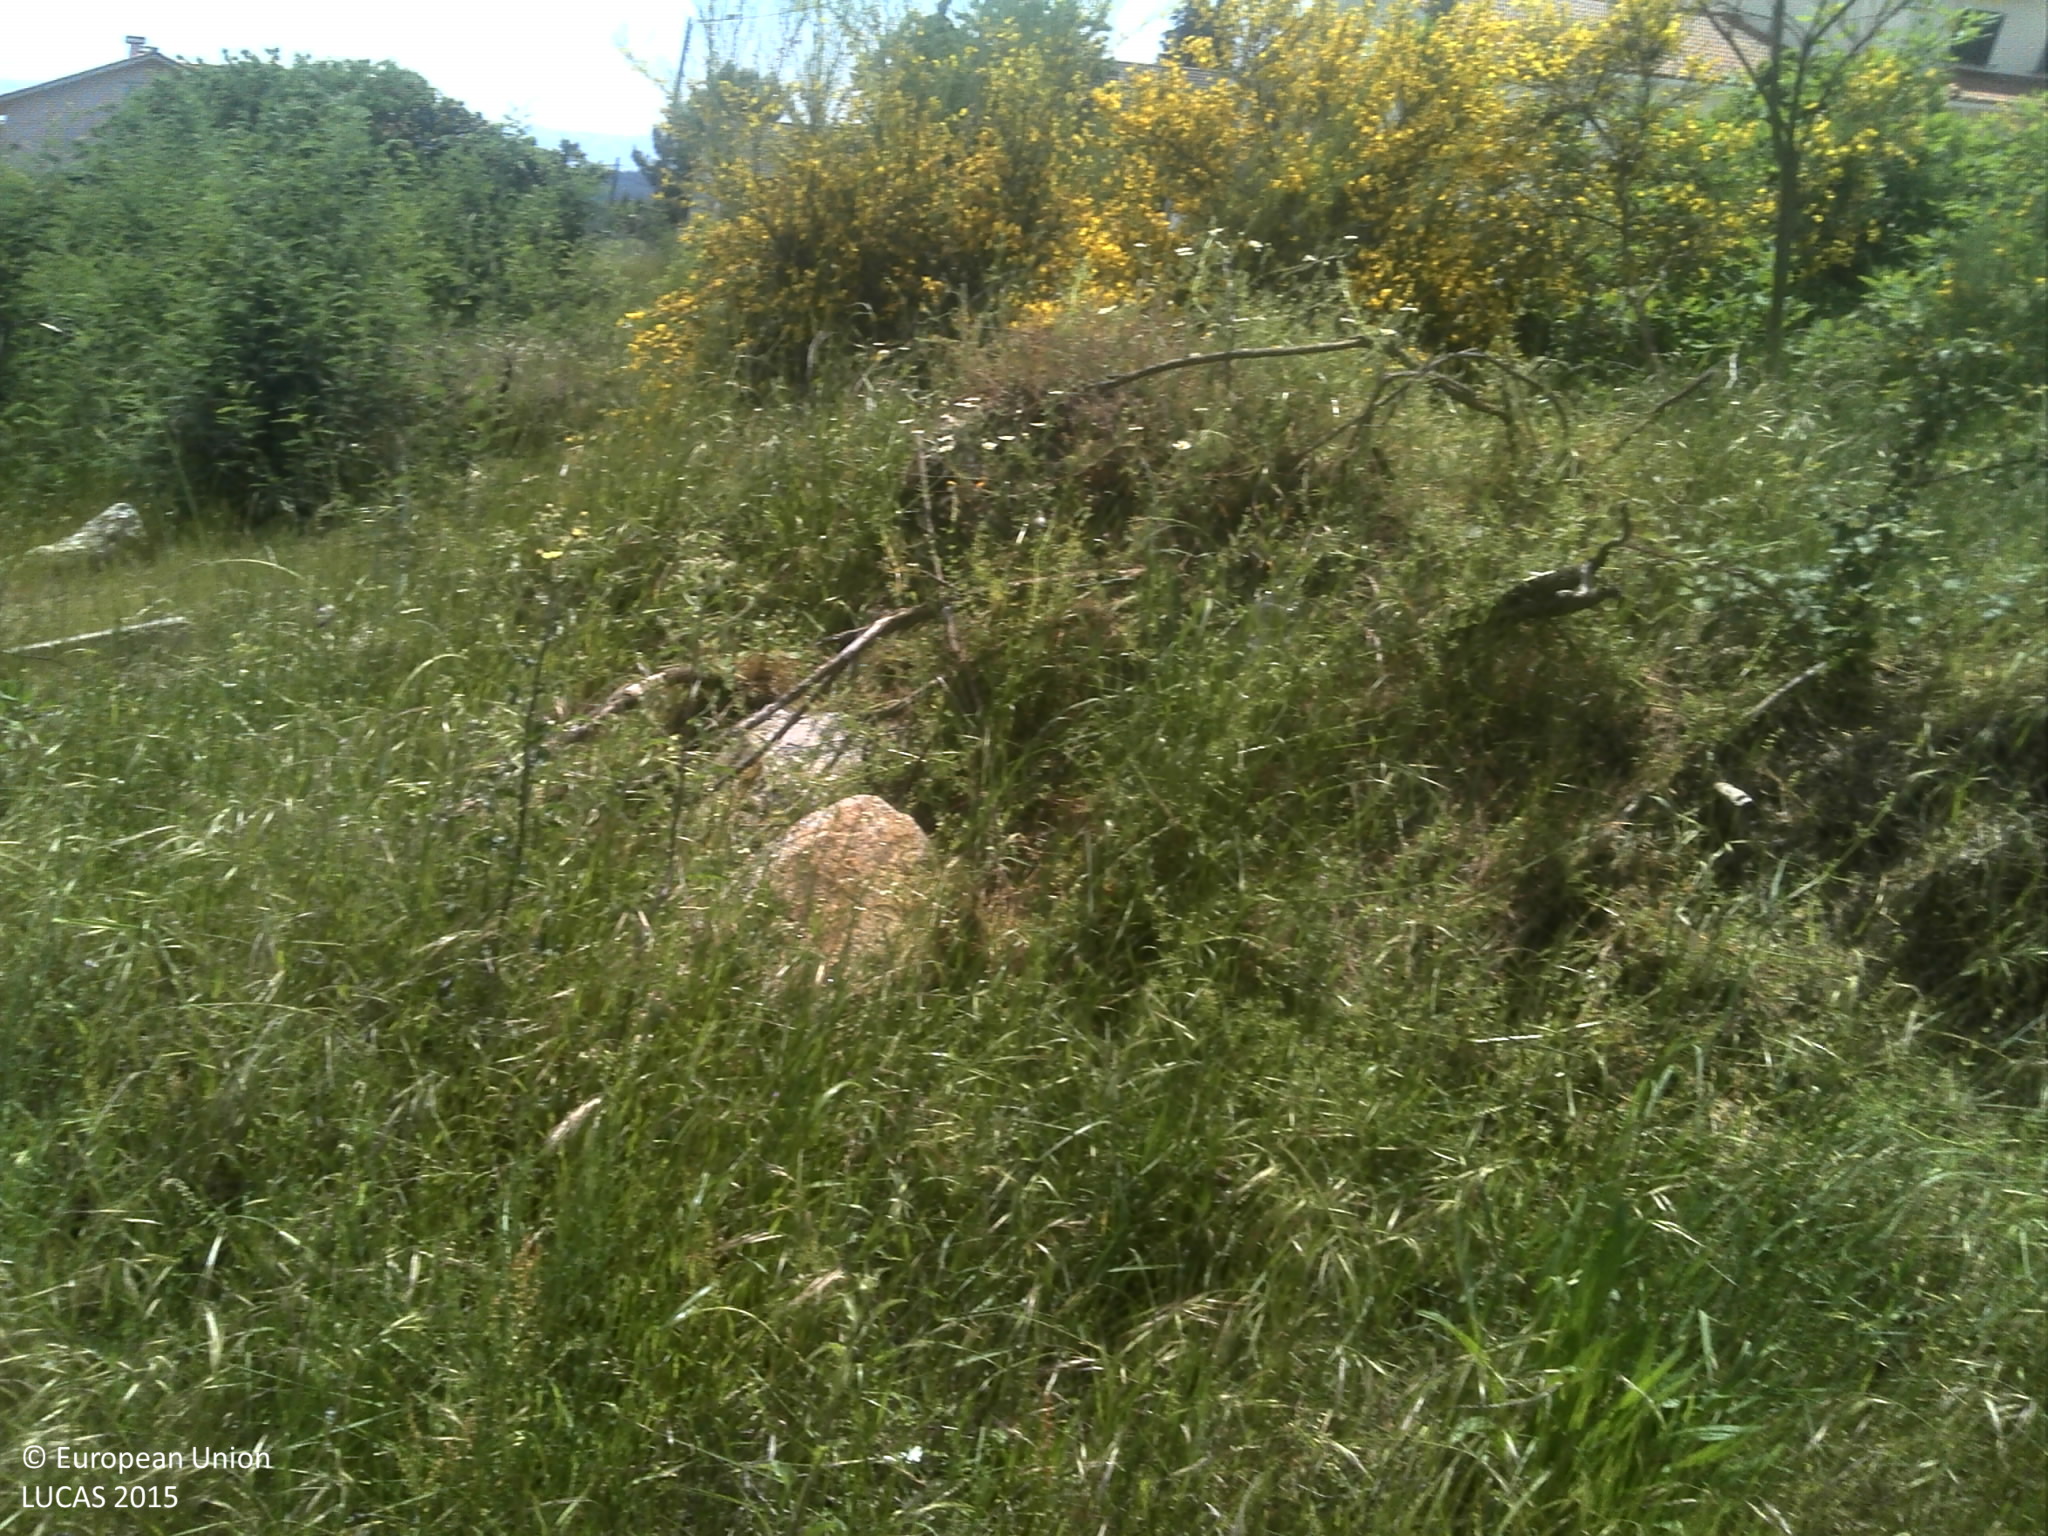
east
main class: Shrubland
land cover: Shrubland without tree cover
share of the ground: 25 - 50 %
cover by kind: shrubs 65 %, herbaceous plants 20 %, consolidated bare surface 15 %
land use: Abandoned areas
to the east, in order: Shrubland without tree cover; Electric lines; Shrubland without tree cover; Grassland without tree/shrub cover; Artificial constructions in urban areas
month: May
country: PT
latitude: 40.5898
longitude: -7.7598
